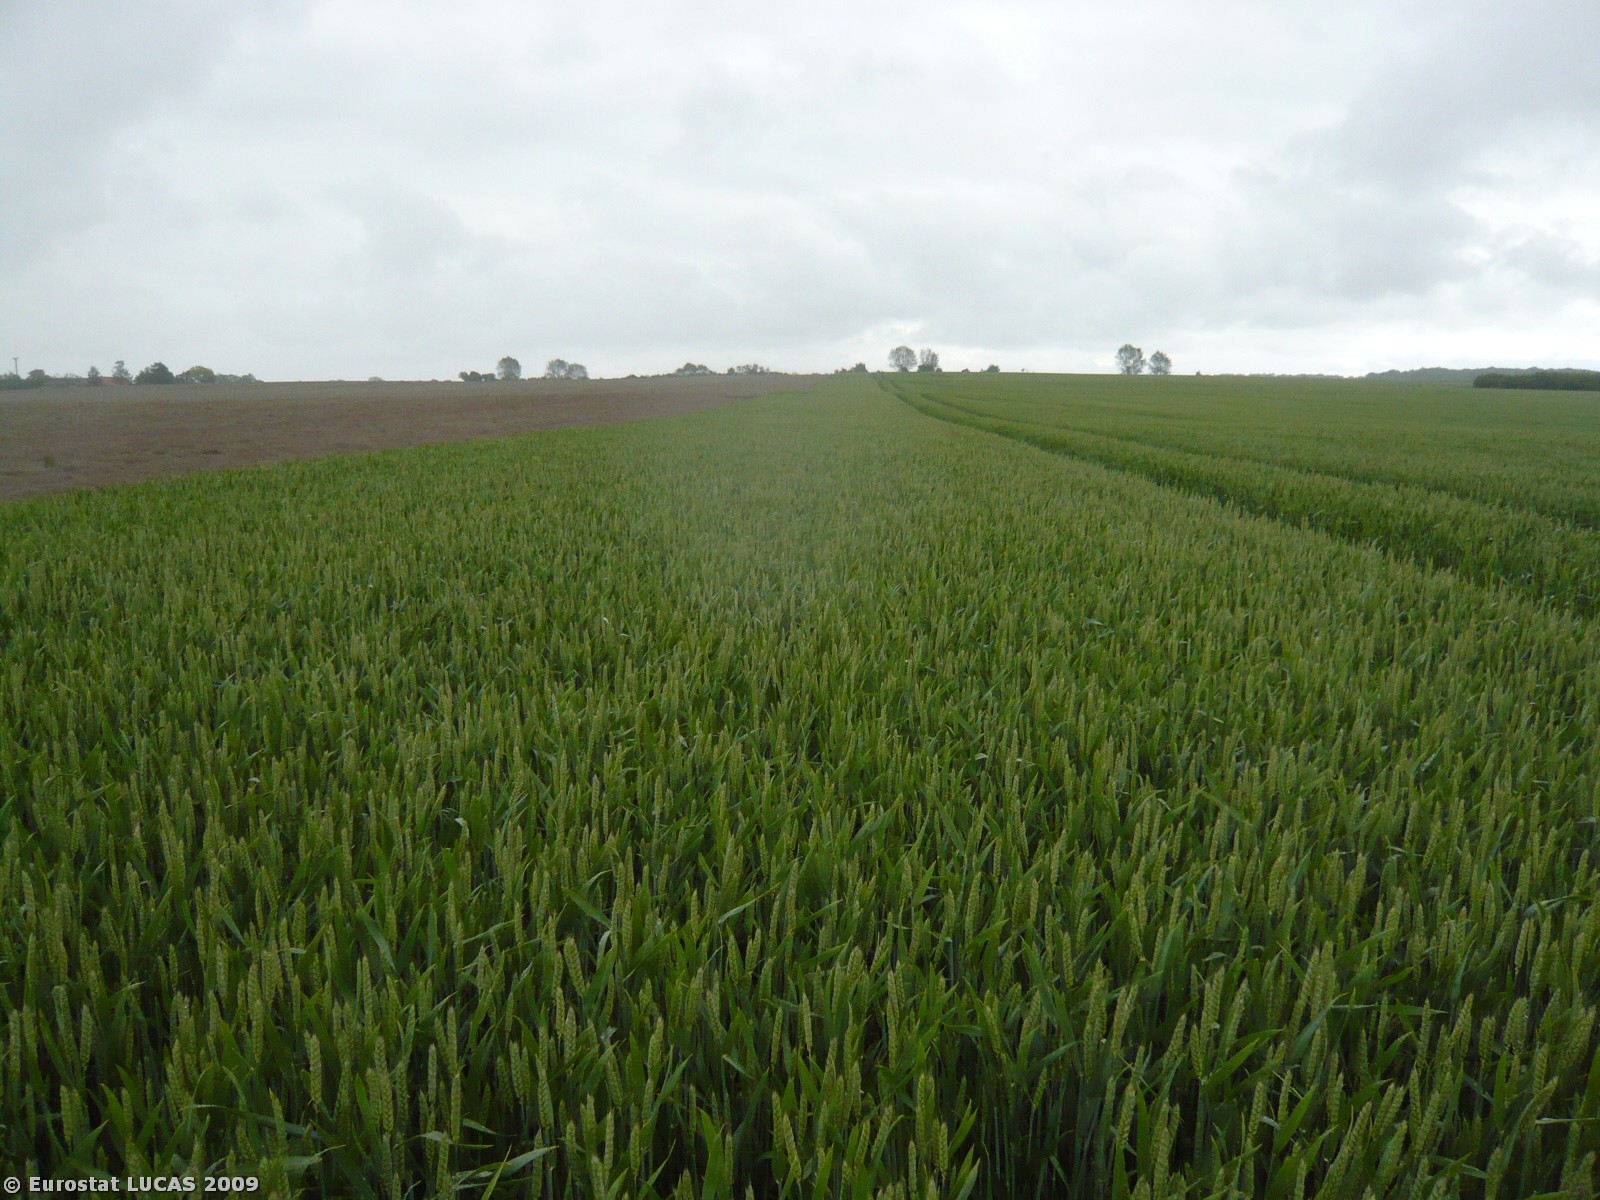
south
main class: Cropland
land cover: Common wheat
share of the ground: > 75 %
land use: Agriculture (excluding fallow land and kitchen gardens)
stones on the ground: 10 - 25 %
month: June
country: DK
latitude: 54.7882
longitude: 11.9738
